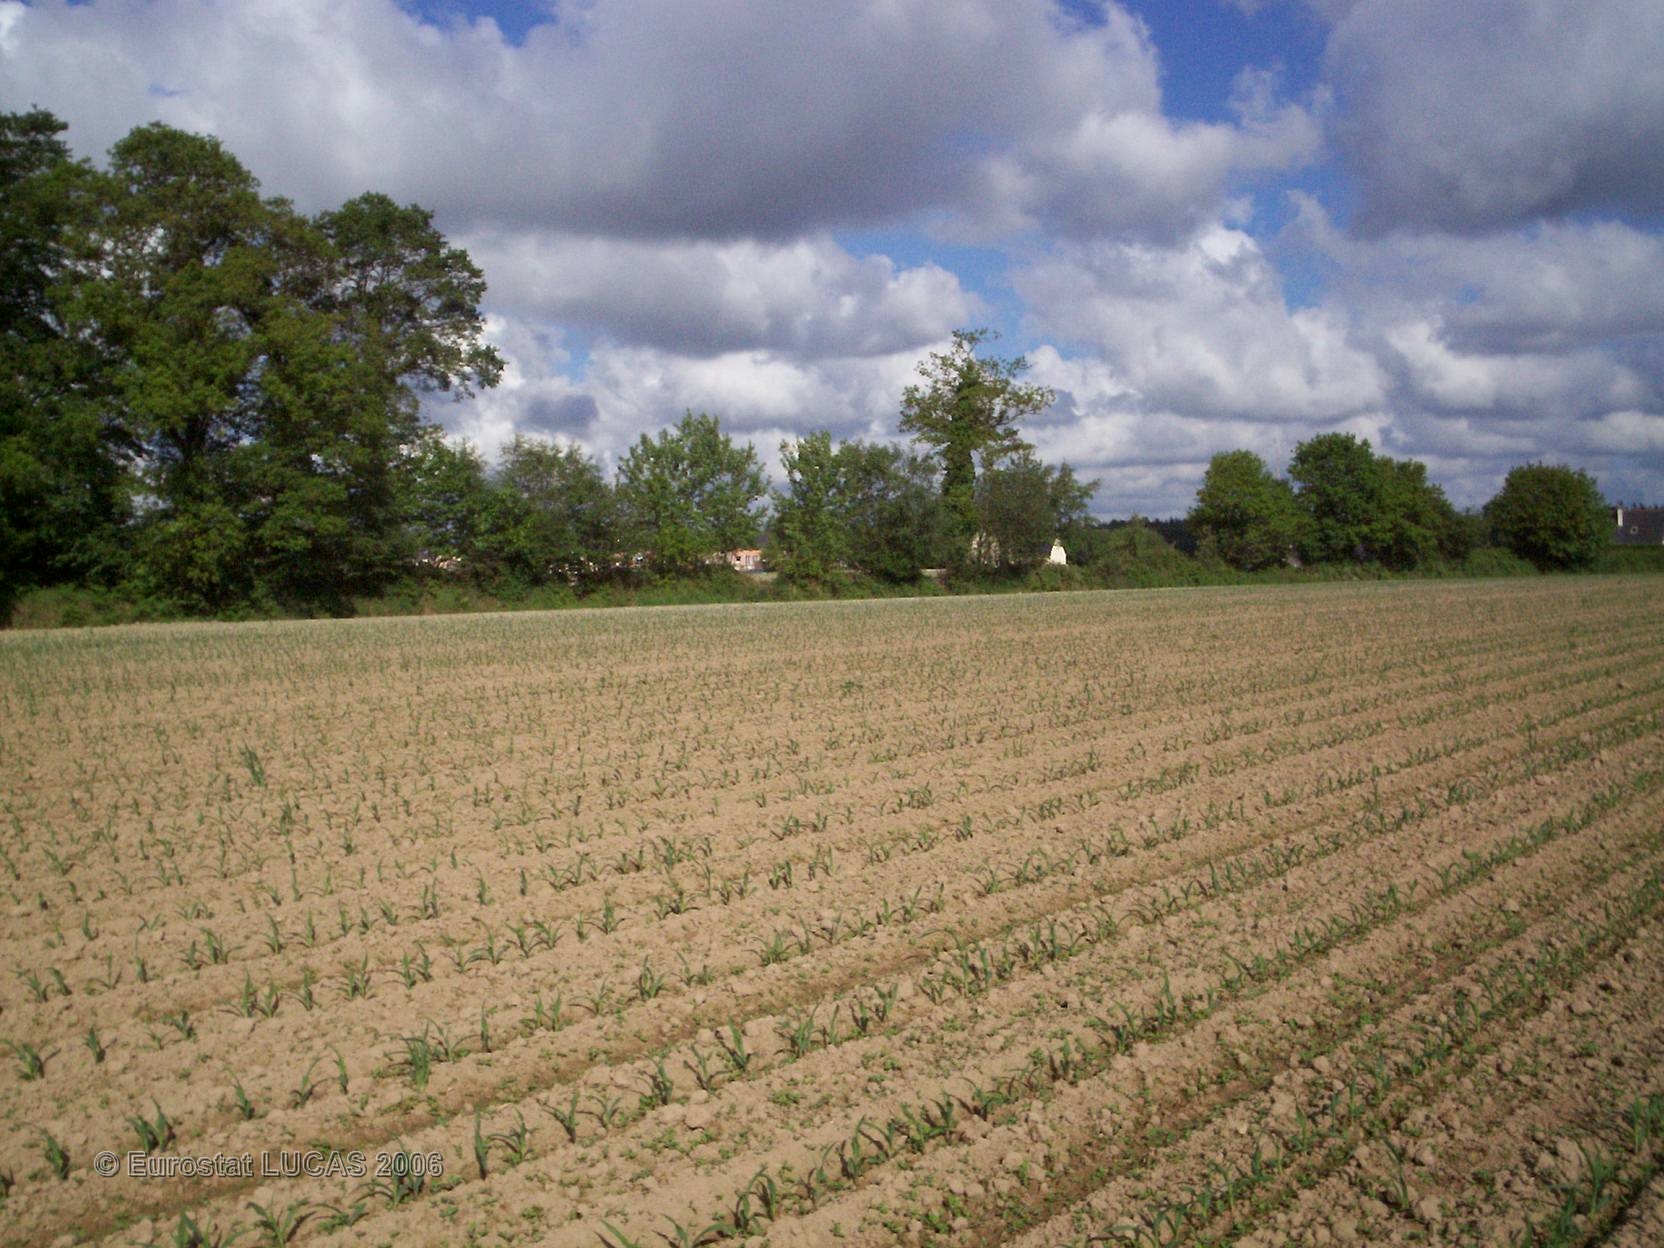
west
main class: Cropland
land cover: Maize
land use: Agriculture (excluding fallow land and kitchen gardens)
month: May
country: FR
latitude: 48.5393
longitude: -3.0325
